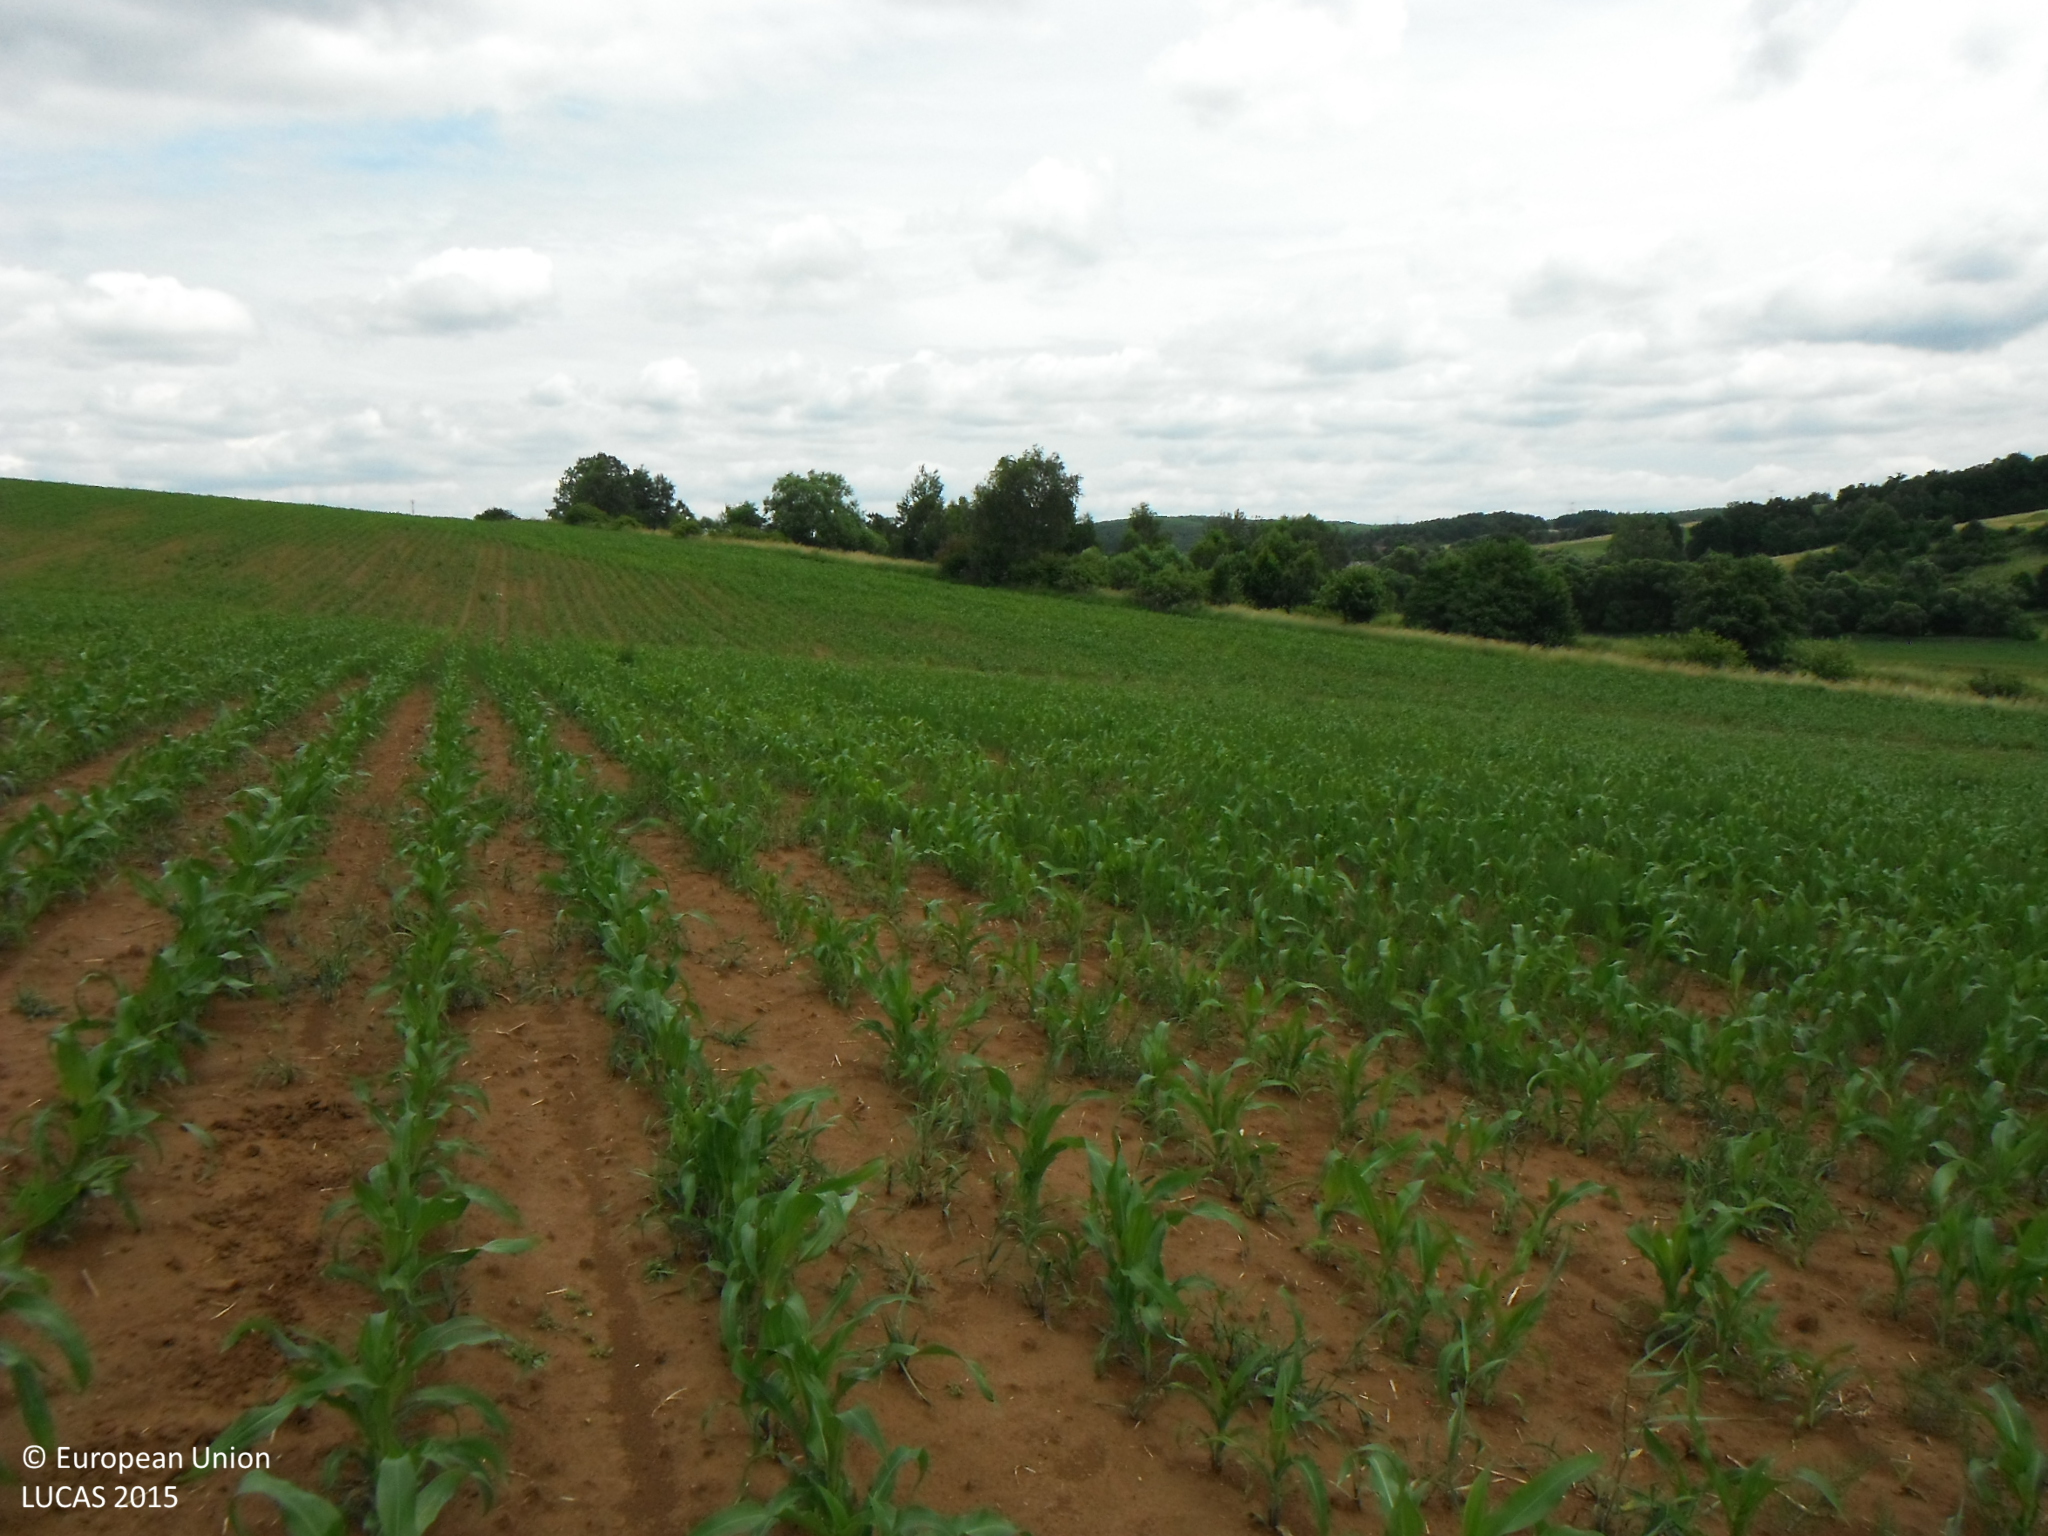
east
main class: Cropland
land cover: Maize
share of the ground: 25 - 50 %
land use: Agriculture (excluding fallow land and kitchen gardens)
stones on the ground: < 10 %
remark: Temporary flooded
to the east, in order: Maize; Grass margins; Ditches and canals; Railways; Ditches and canals; Spontaneously vegetated surfaces; Broadleaved woodland
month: June
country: SK
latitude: 49.0483
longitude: 21.3895
